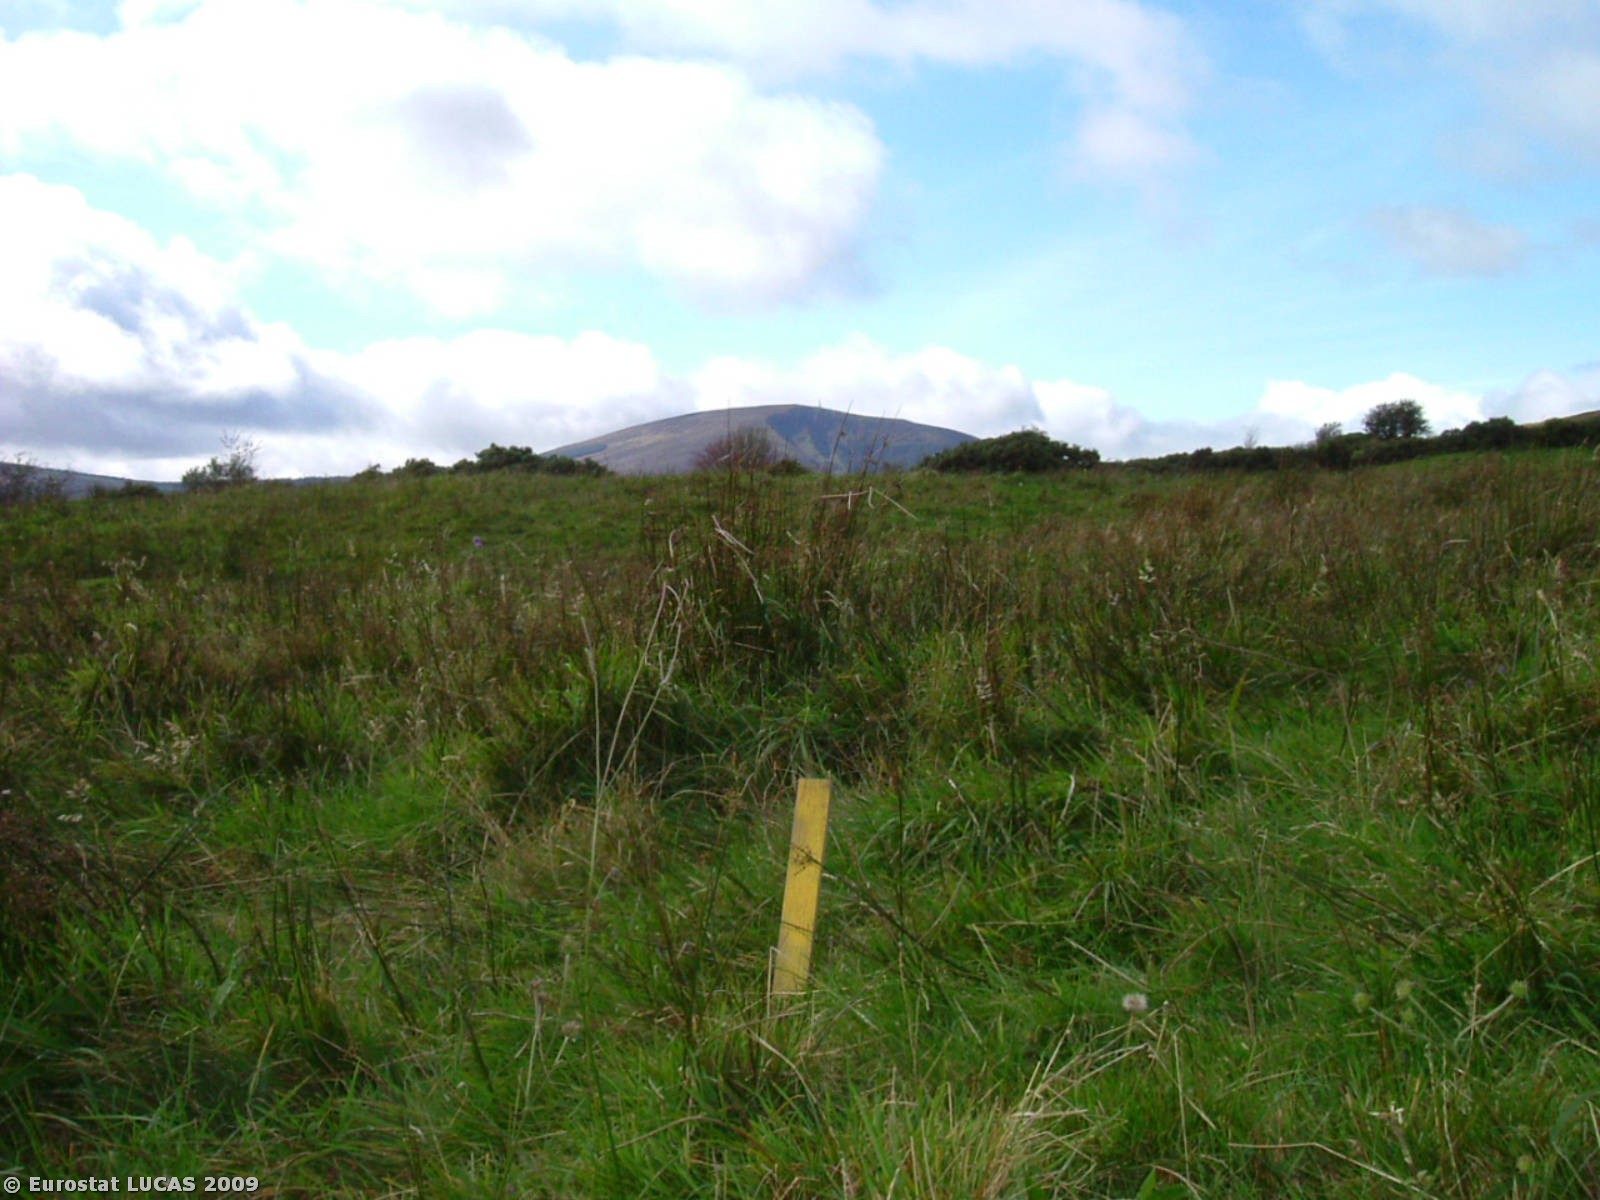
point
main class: Grassland
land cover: Grassland without tree/shrub cover
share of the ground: > 75 %
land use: Agriculture (excluding fallow land and kitchen gardens)
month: September
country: IE
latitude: 52.7637
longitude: -8.1885
